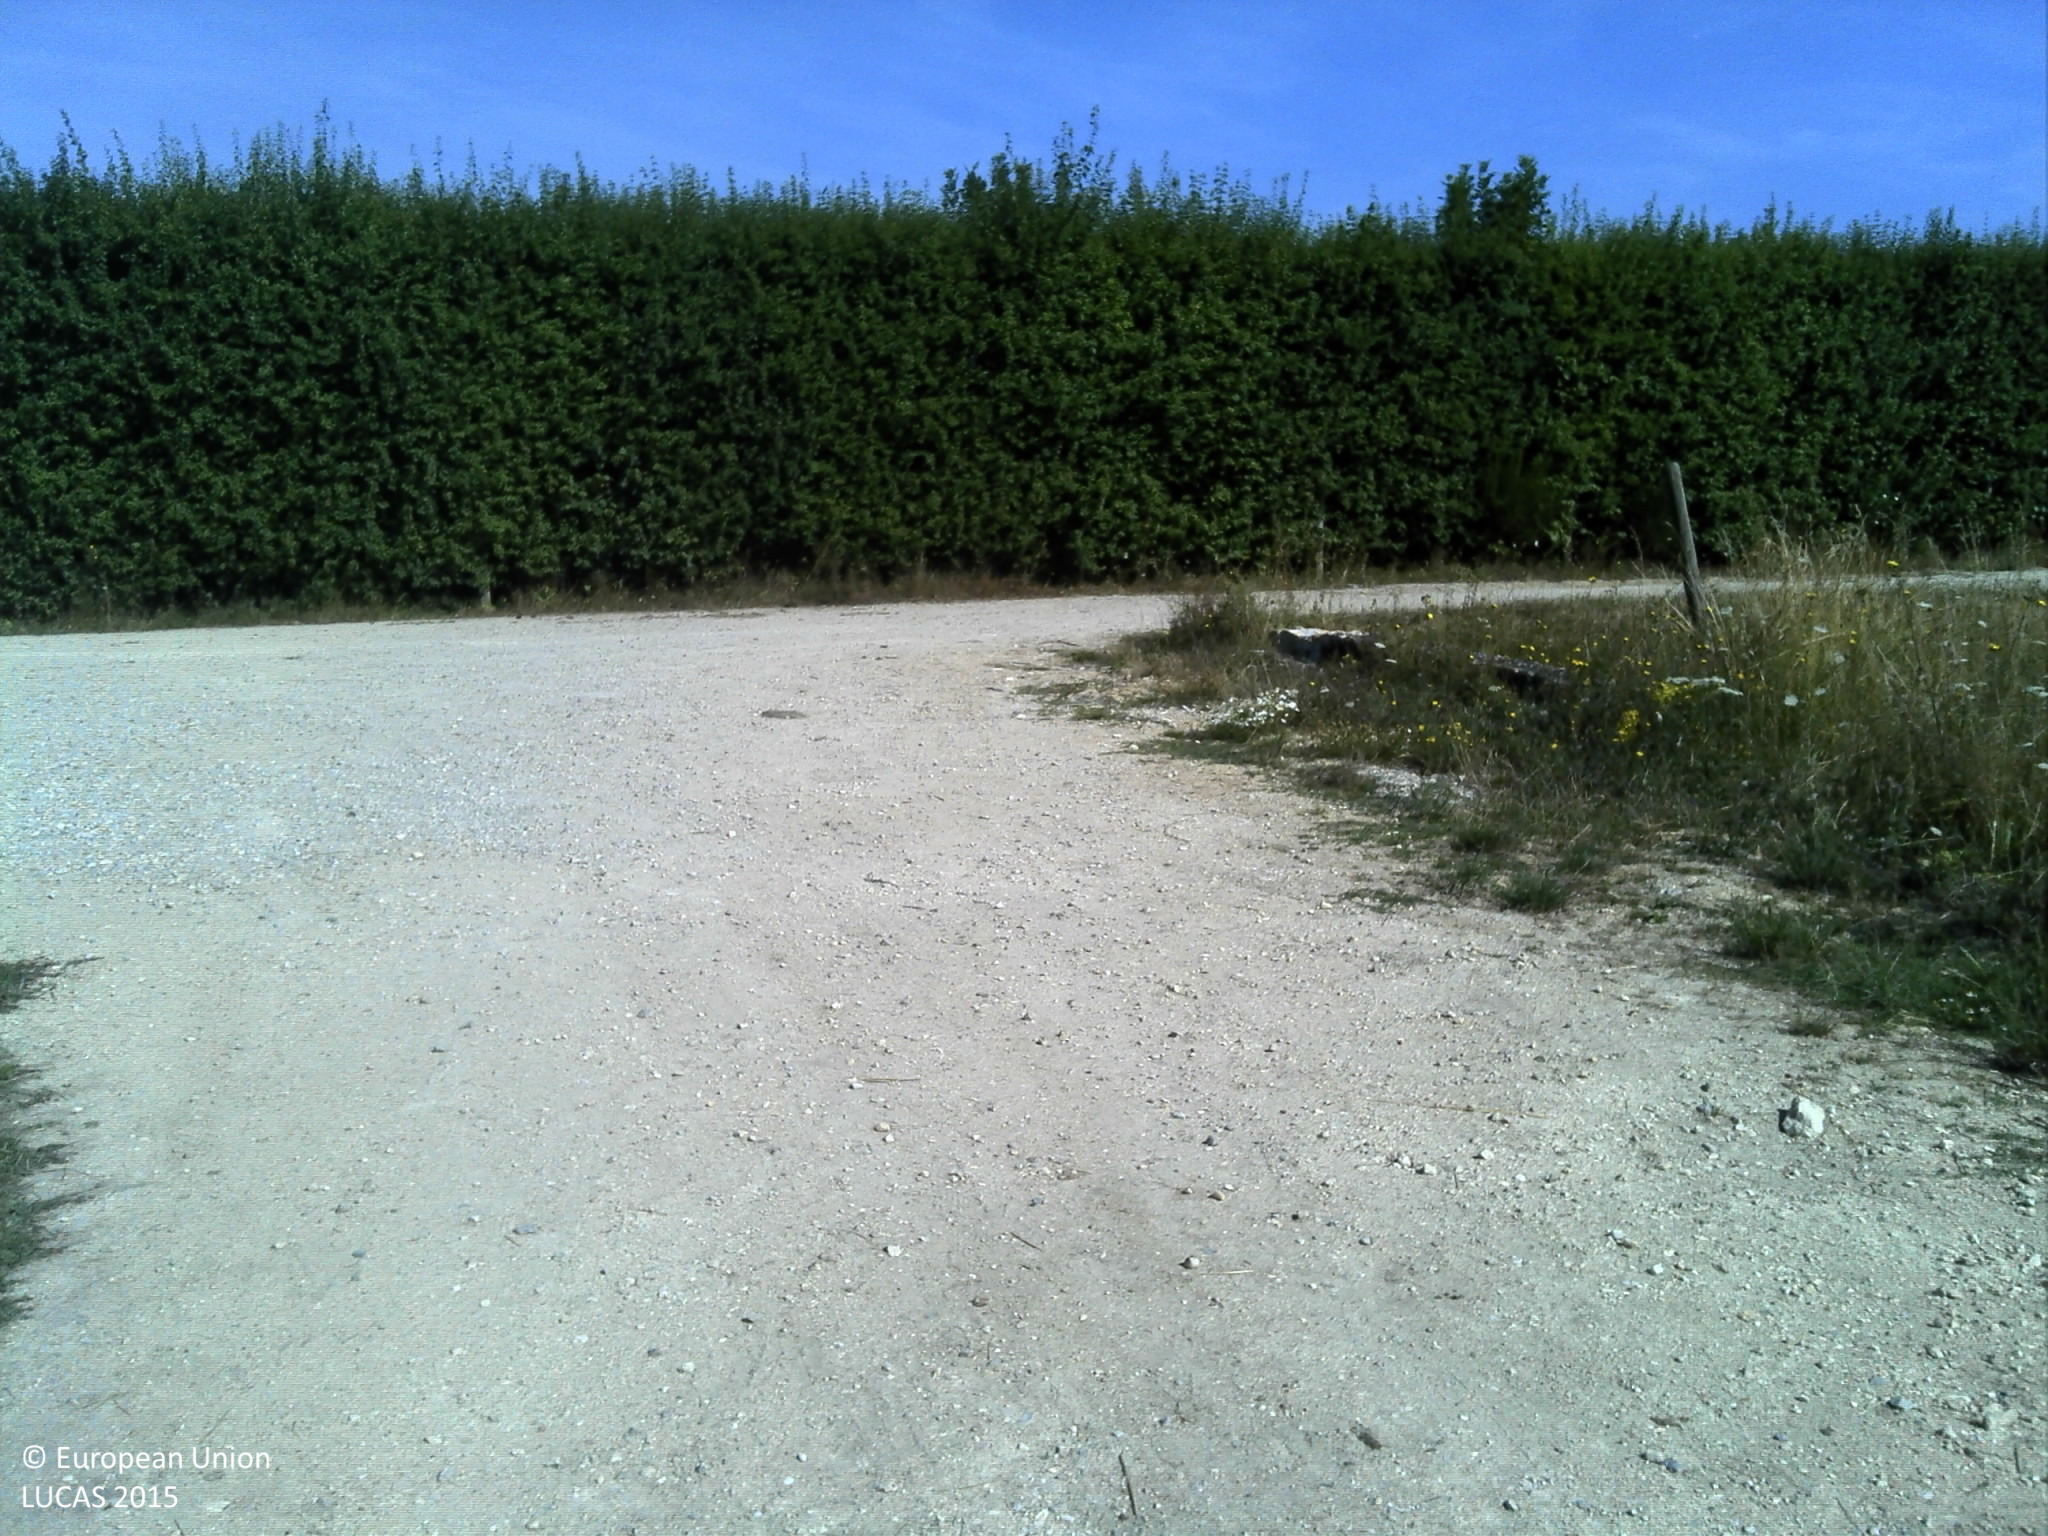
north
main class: Grassland
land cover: Grassland without tree/shrub cover
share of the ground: > 75 %
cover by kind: herbaceous plants 100 %
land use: Agriculture (excluding fallow land and kitchen gardens)
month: August
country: FR
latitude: 48.6670
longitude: 1.9064
